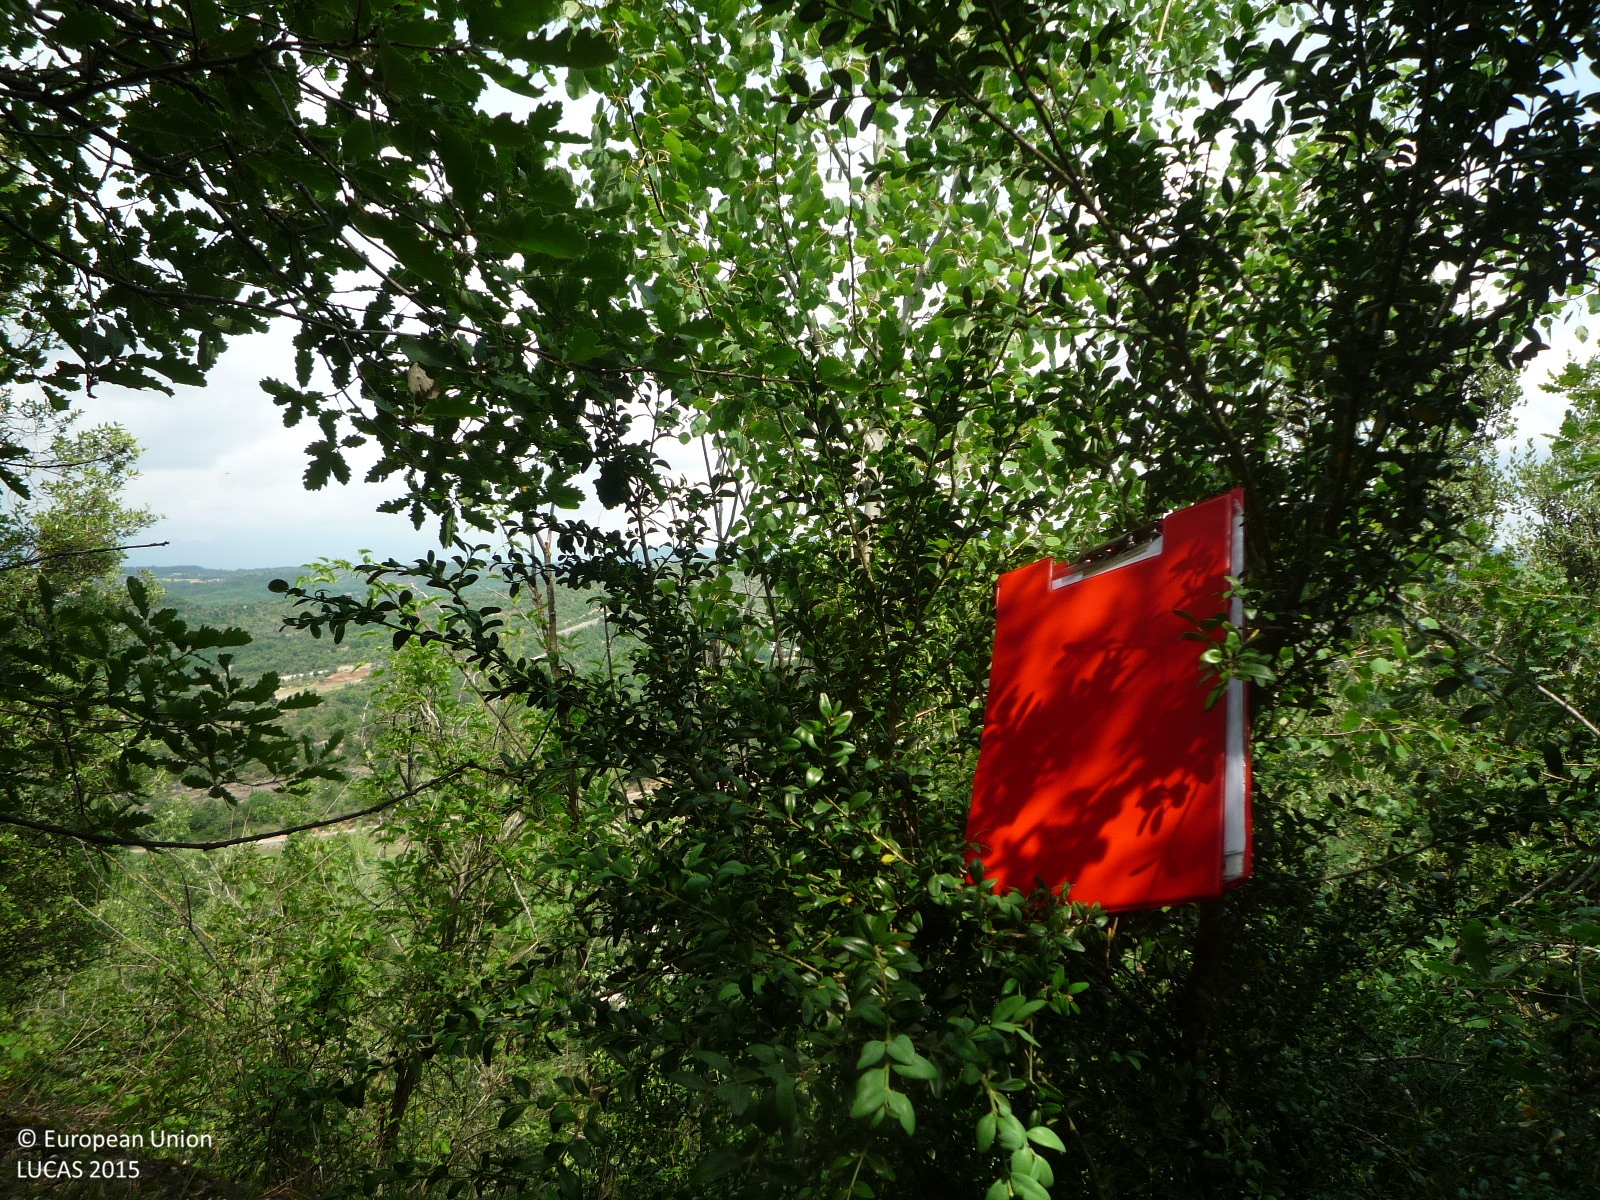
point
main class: Woodland
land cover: Broadleaved woodland
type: broadleaved evergreen forest
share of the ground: > 75 %
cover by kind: broadleaved forest trees 100 %
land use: Semi-natural and natural areas not in use
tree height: < 5 m
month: June
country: ES
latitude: 42.0292
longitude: 2.0058
